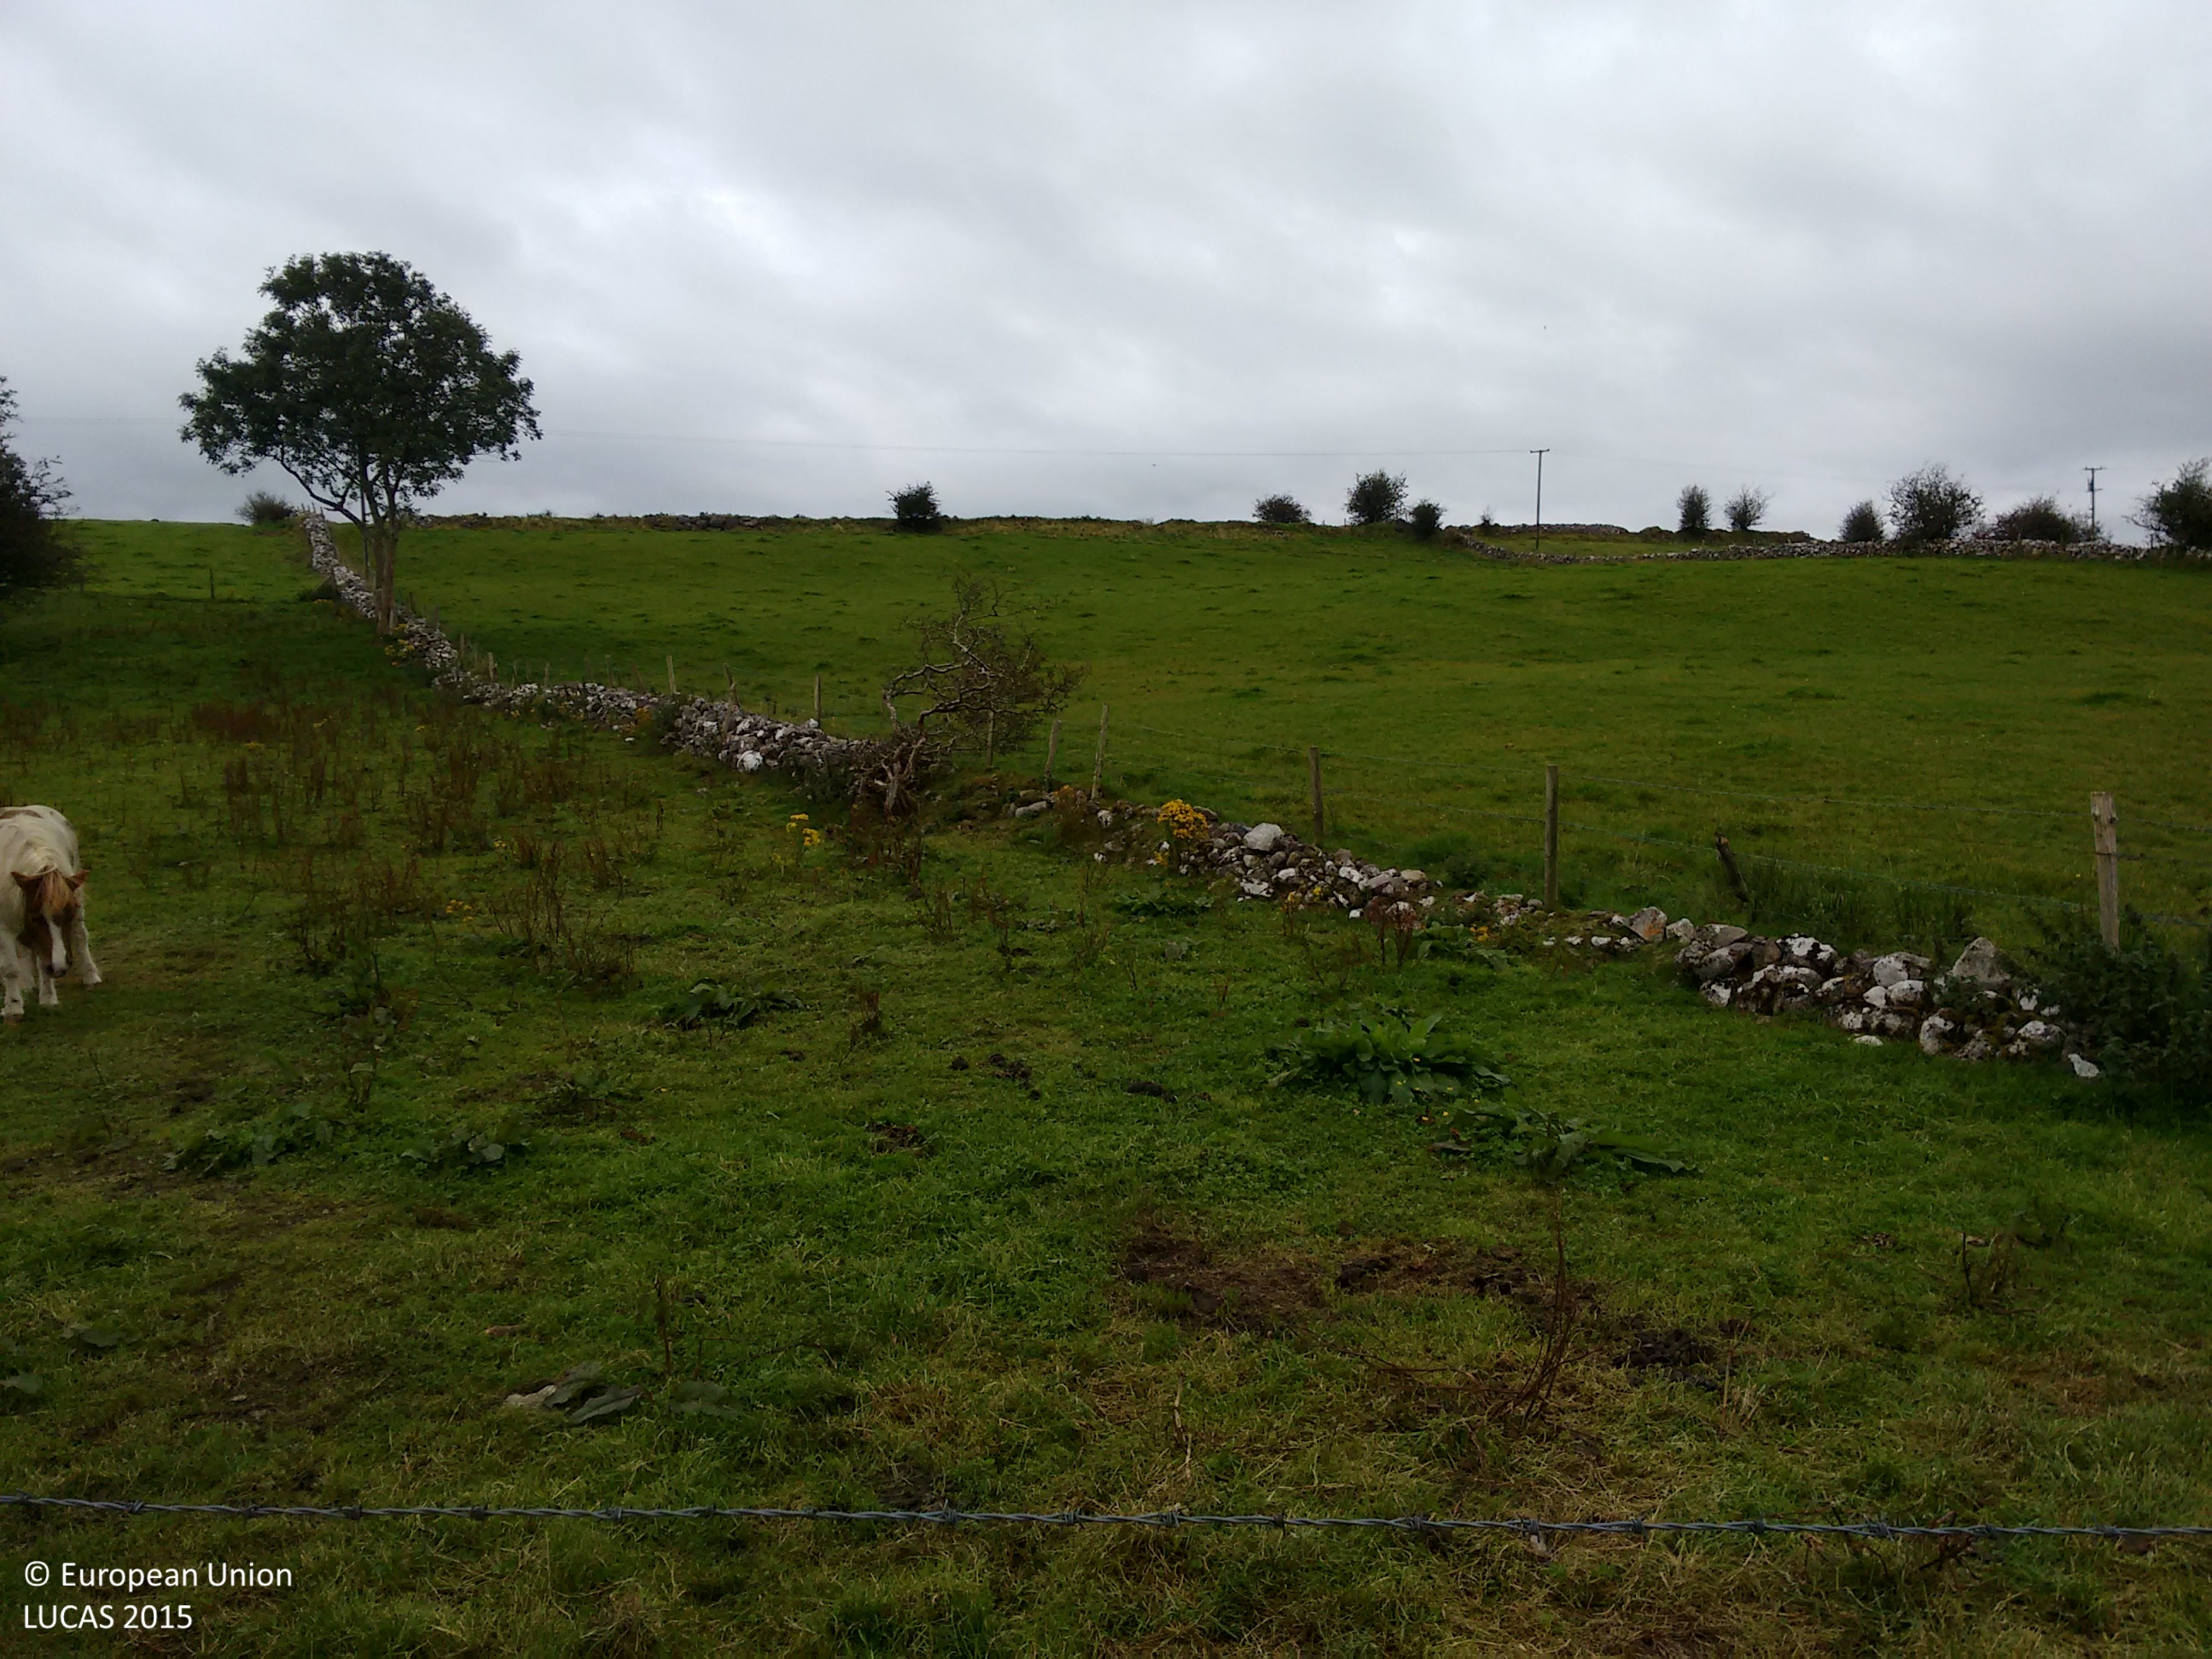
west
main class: Grassland
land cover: Grassland without tree/shrub cover
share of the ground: > 75 %
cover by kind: herbaceous plants 100 %
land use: Agriculture (excluding fallow land and kitchen gardens)
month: September
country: IE
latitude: 53.8479
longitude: -8.8253
